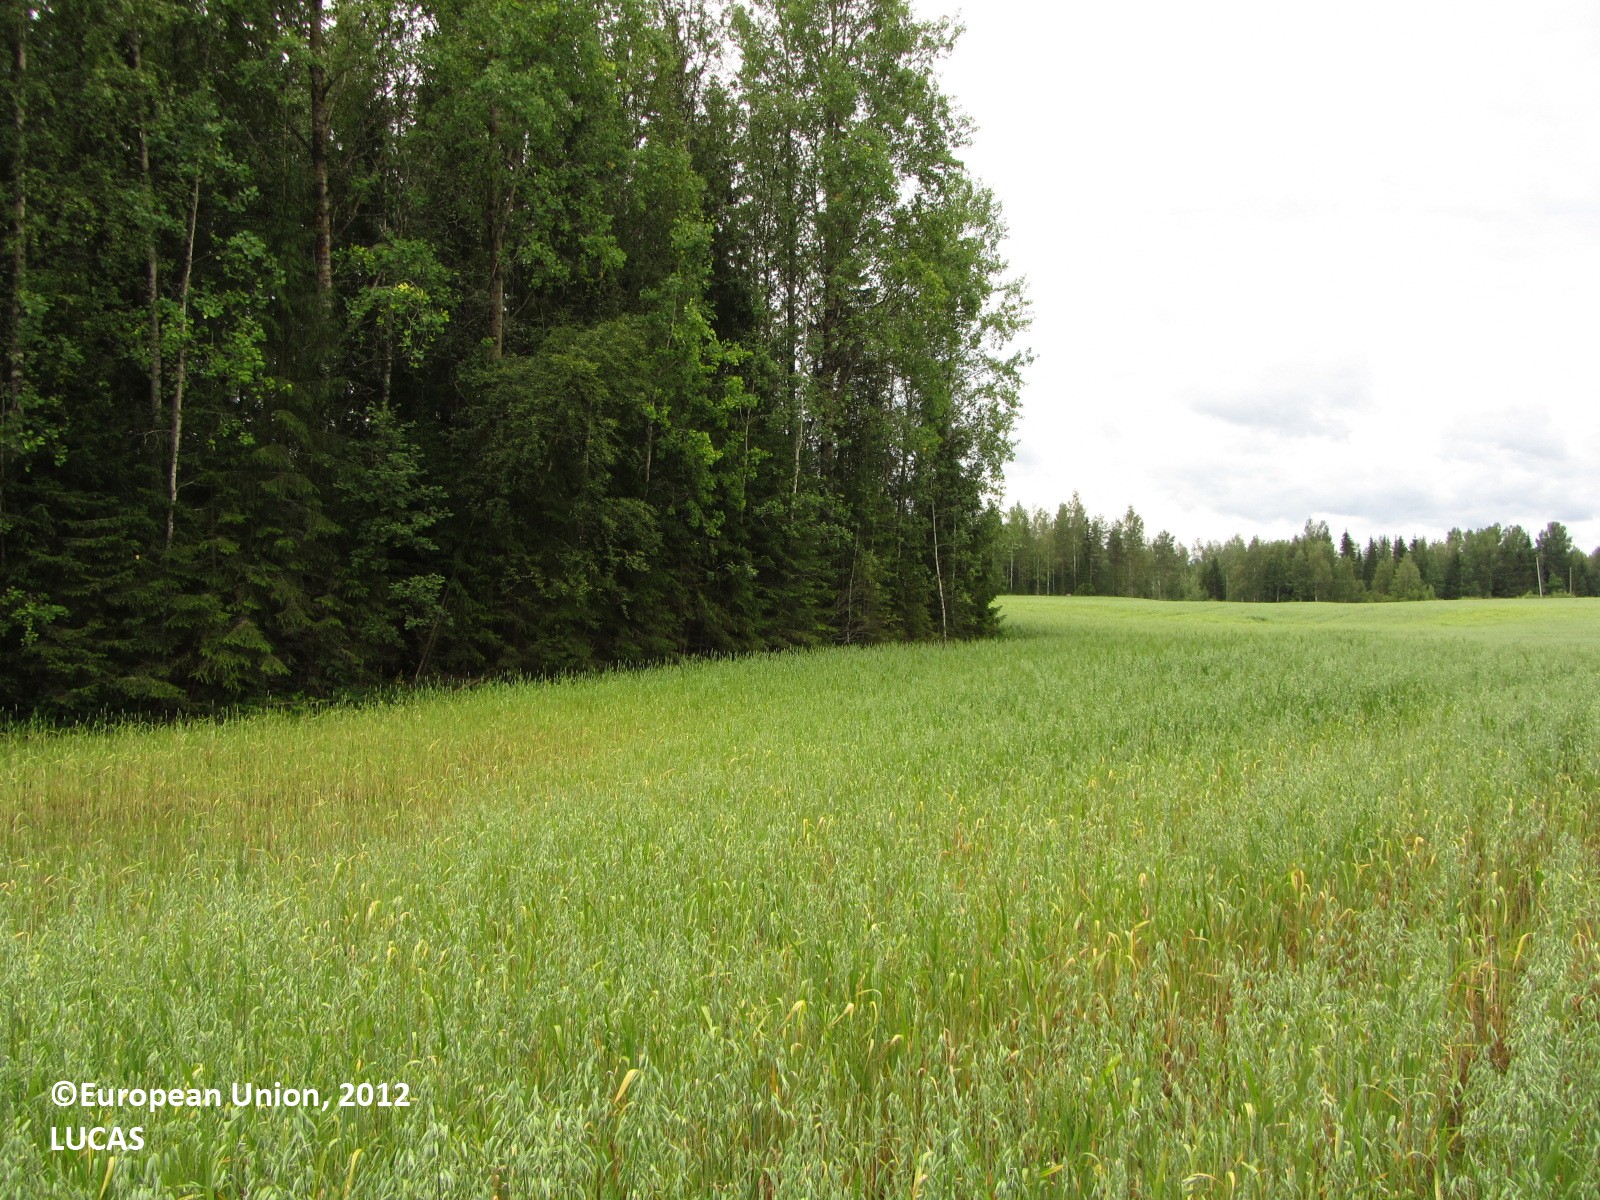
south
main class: Cropland
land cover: Mixed cereals for fodder
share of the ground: > 75 %
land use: Agriculture (excluding fallow land and kitchen gardens)
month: August
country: FI
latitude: 63.4452
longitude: 25.3153
